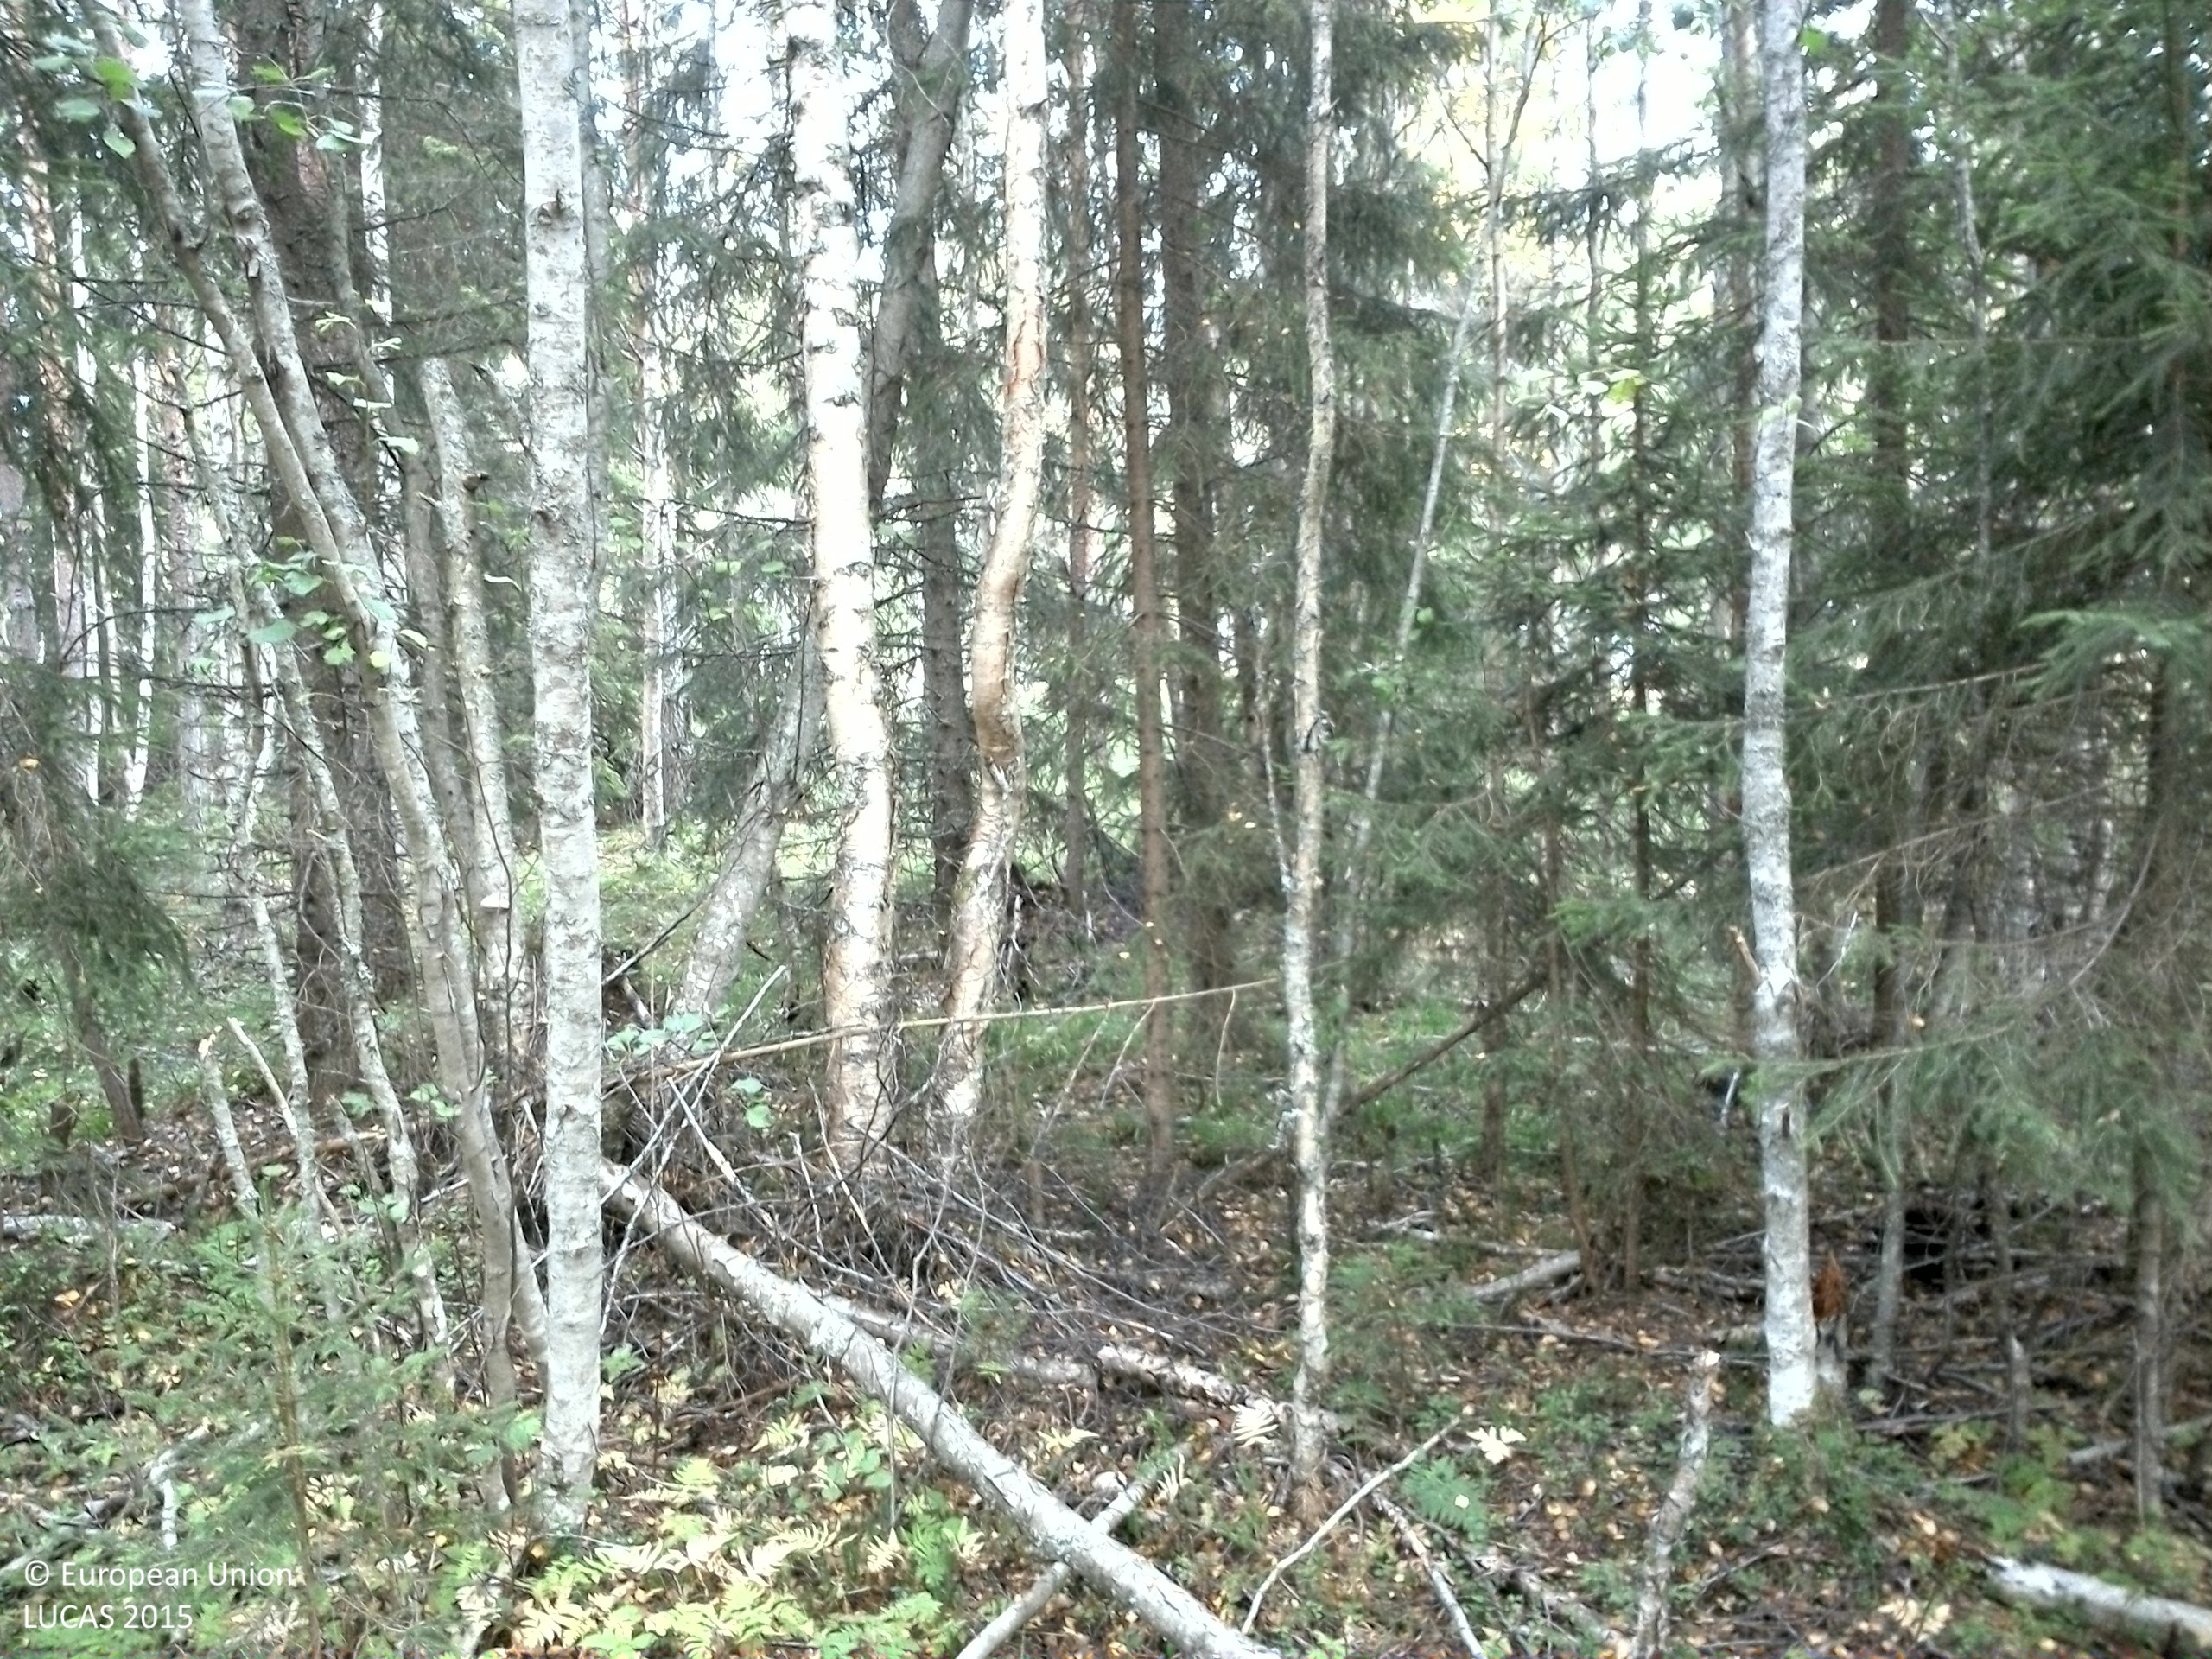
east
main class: Woodland
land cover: Spruce dominated mixed woodland
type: boreal forest
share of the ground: > 75 %
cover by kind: coniferous forest trees 50 %, broadleaved forest trees 25 %, shrubs 20 %, lichens and mosses 5 %
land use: Forestry
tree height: > 5 m
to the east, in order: Spruce dominated mixed woodland; Ditches and canals; Grass margins; Paved roads, cycling and walking lanes; Grass margins; Spruce dominated mixed woodland; Rivers and streams; Spruce dominated mixed woodland; Rivers and streams; Spruce dominated mixed woodland; Other coniferous woodland
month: September
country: SE
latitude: 61.2684
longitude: 15.4116
